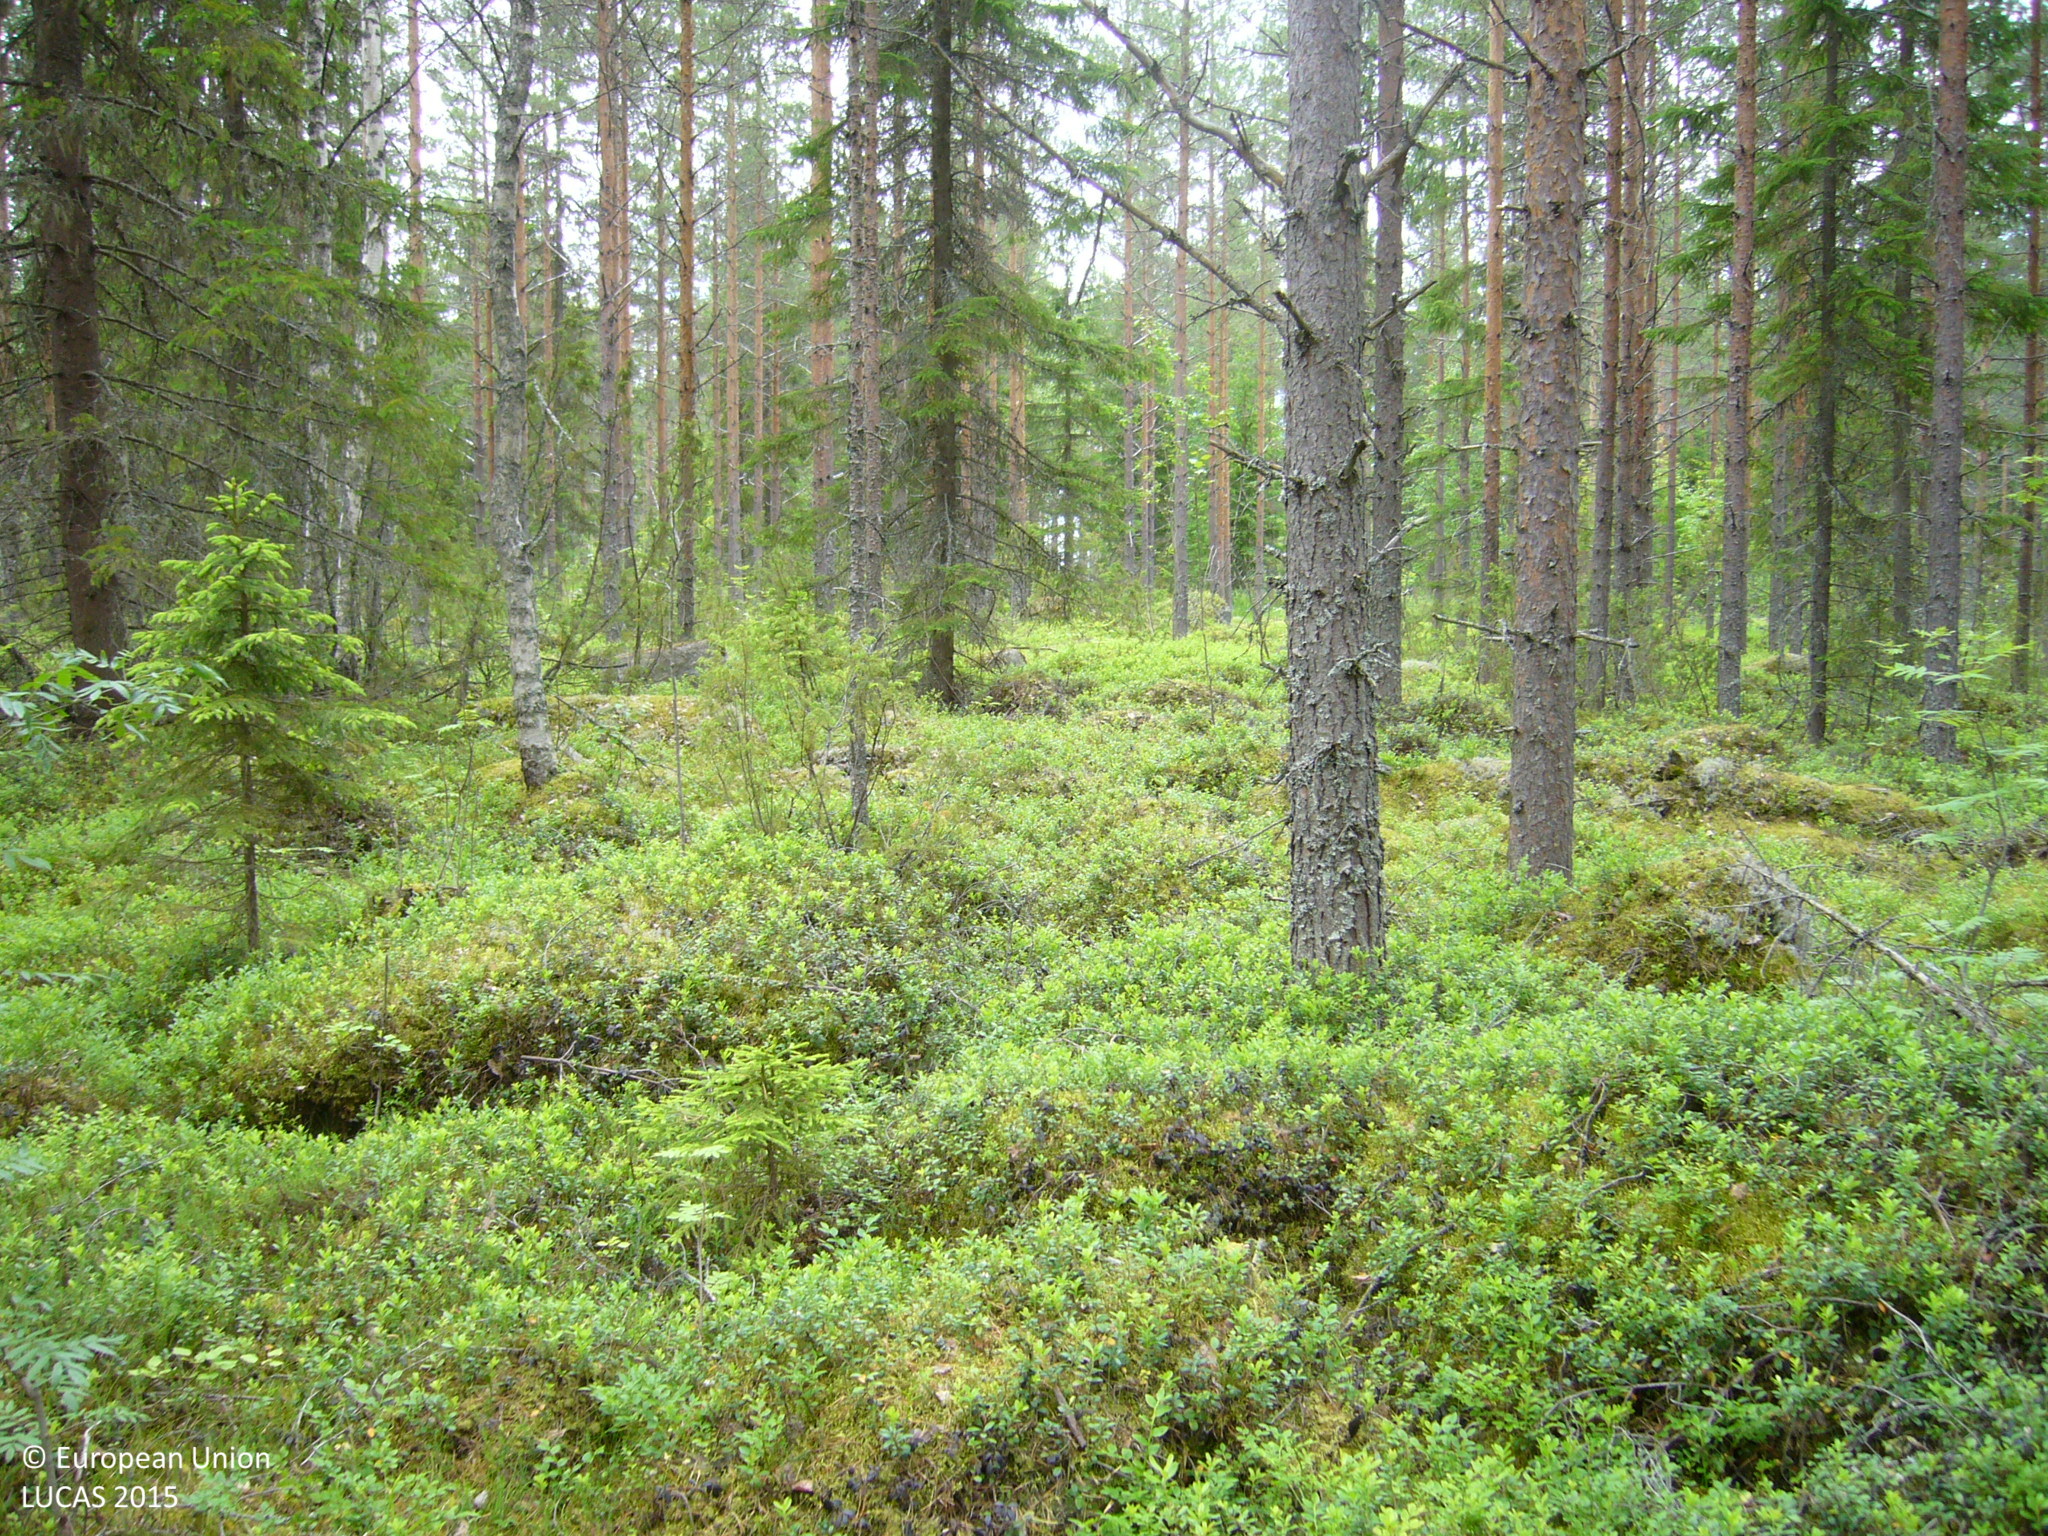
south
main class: Woodland
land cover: Pine dominated coniferous woodland
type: boreal forest
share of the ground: 50 - 75 %
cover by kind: coniferous forest trees 60 %, shrubs 40 %
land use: Forestry
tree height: > 5 m
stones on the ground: 25 - 50 %
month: July
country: FI
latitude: 63.4266
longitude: 26.2090
